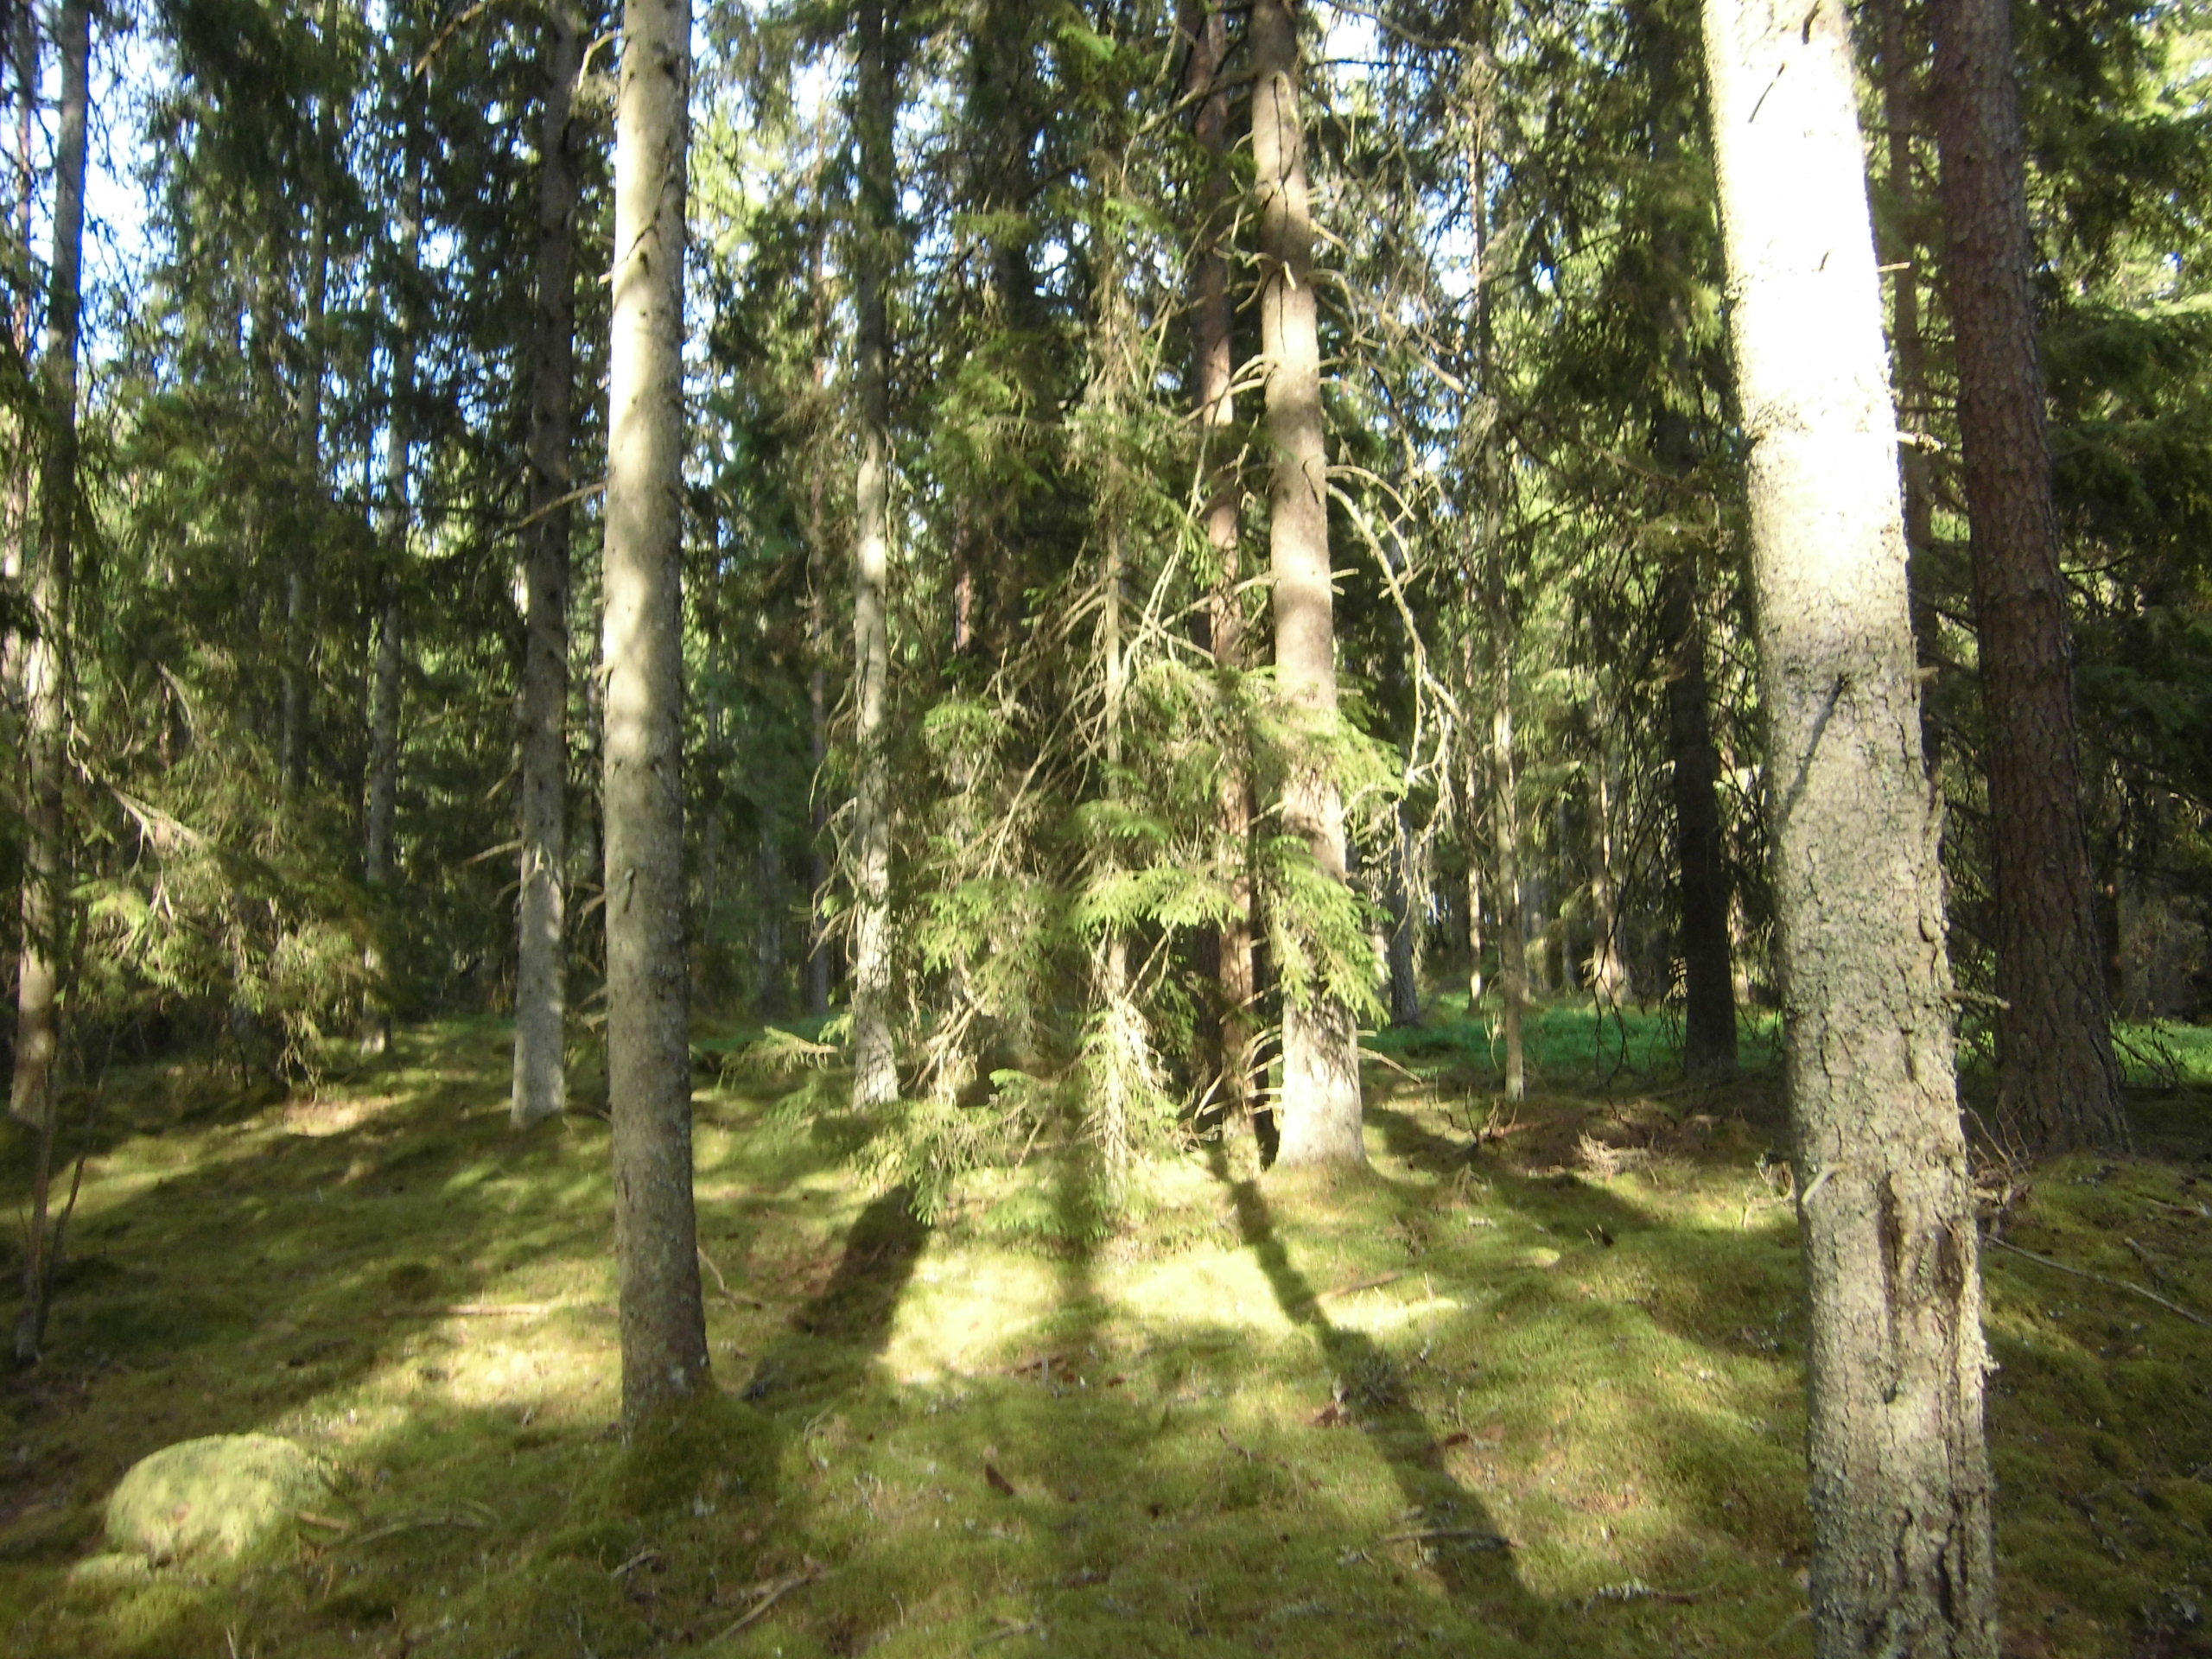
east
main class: Woodland
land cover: Spruce dominated coniferous woodland
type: boreal forest
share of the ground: 50 - 75 %
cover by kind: coniferous forest trees 55 %, lichens and mosses 25 %, shrubs 20 %
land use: Forestry
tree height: > 5 m
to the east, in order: Spruce dominated coniferous woodland; Tracks; Spruce dominated coniferous woodland
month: July
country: SE
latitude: 57.3447
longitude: 14.6986
